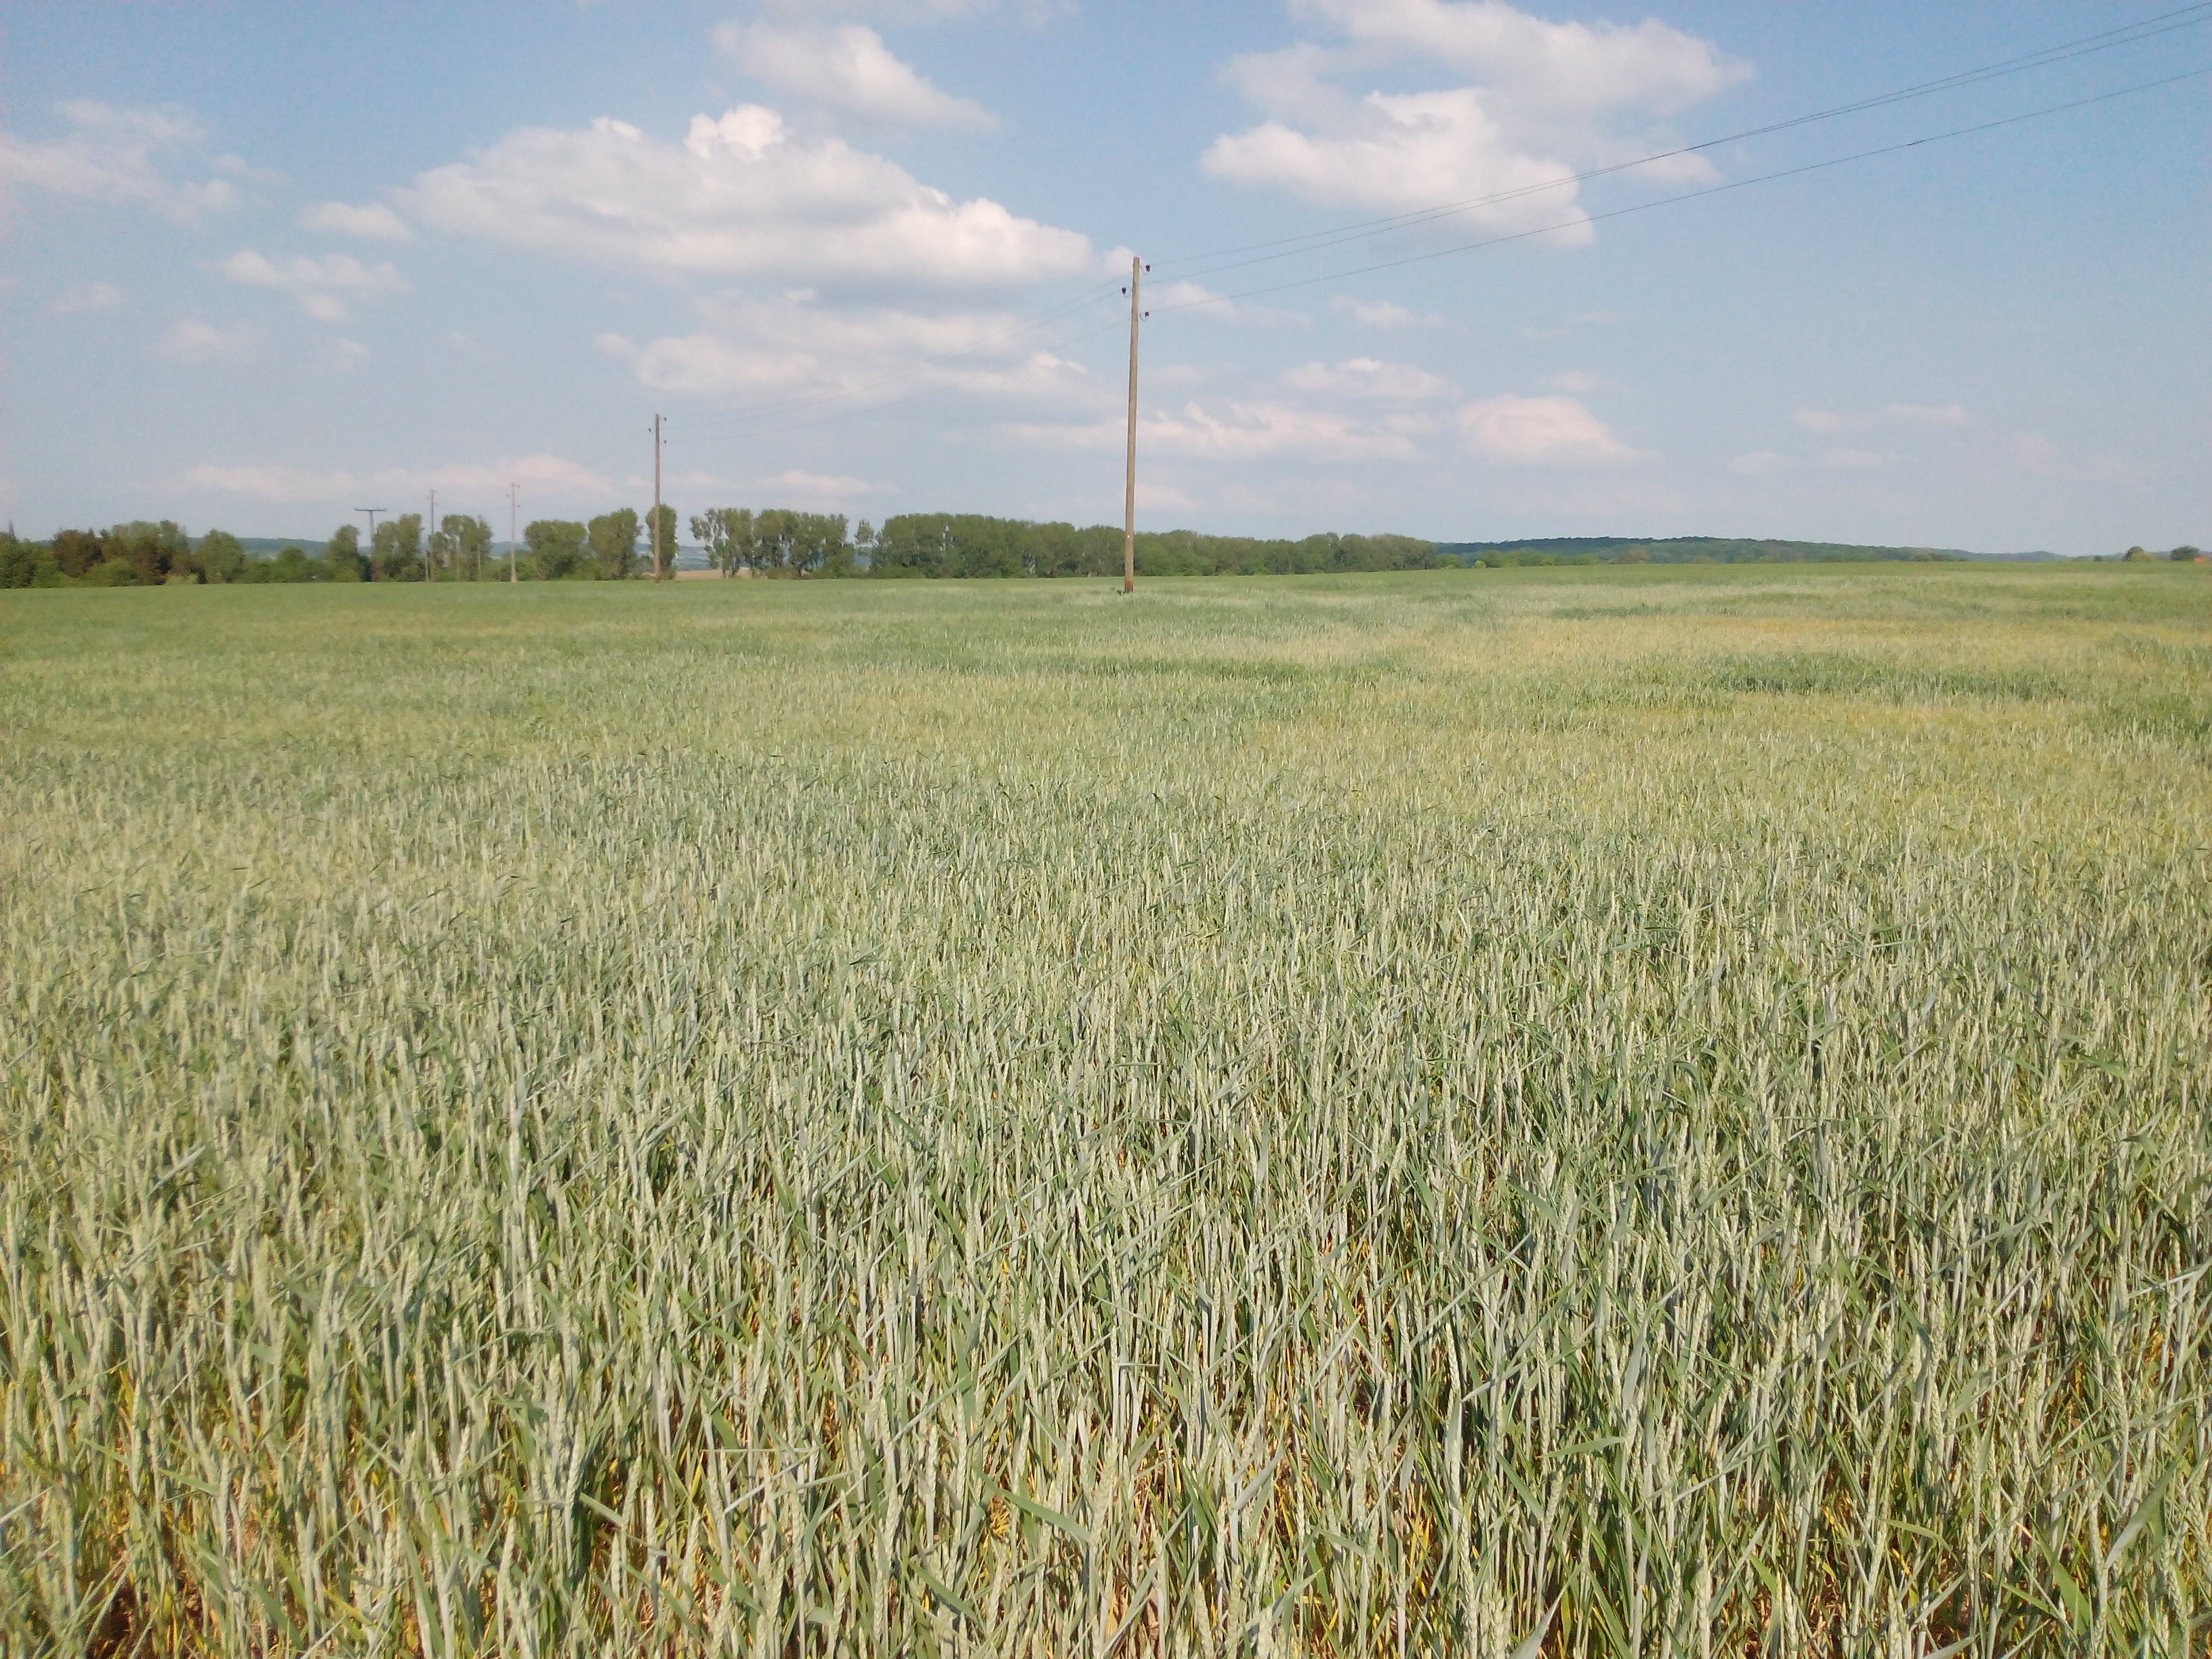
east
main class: Cropland
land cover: Common wheat
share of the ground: > 75 %
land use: Agriculture (excluding fallow land and kitchen gardens)
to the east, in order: Common wheat
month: June
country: DE
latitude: 50.9381
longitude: 10.5548
